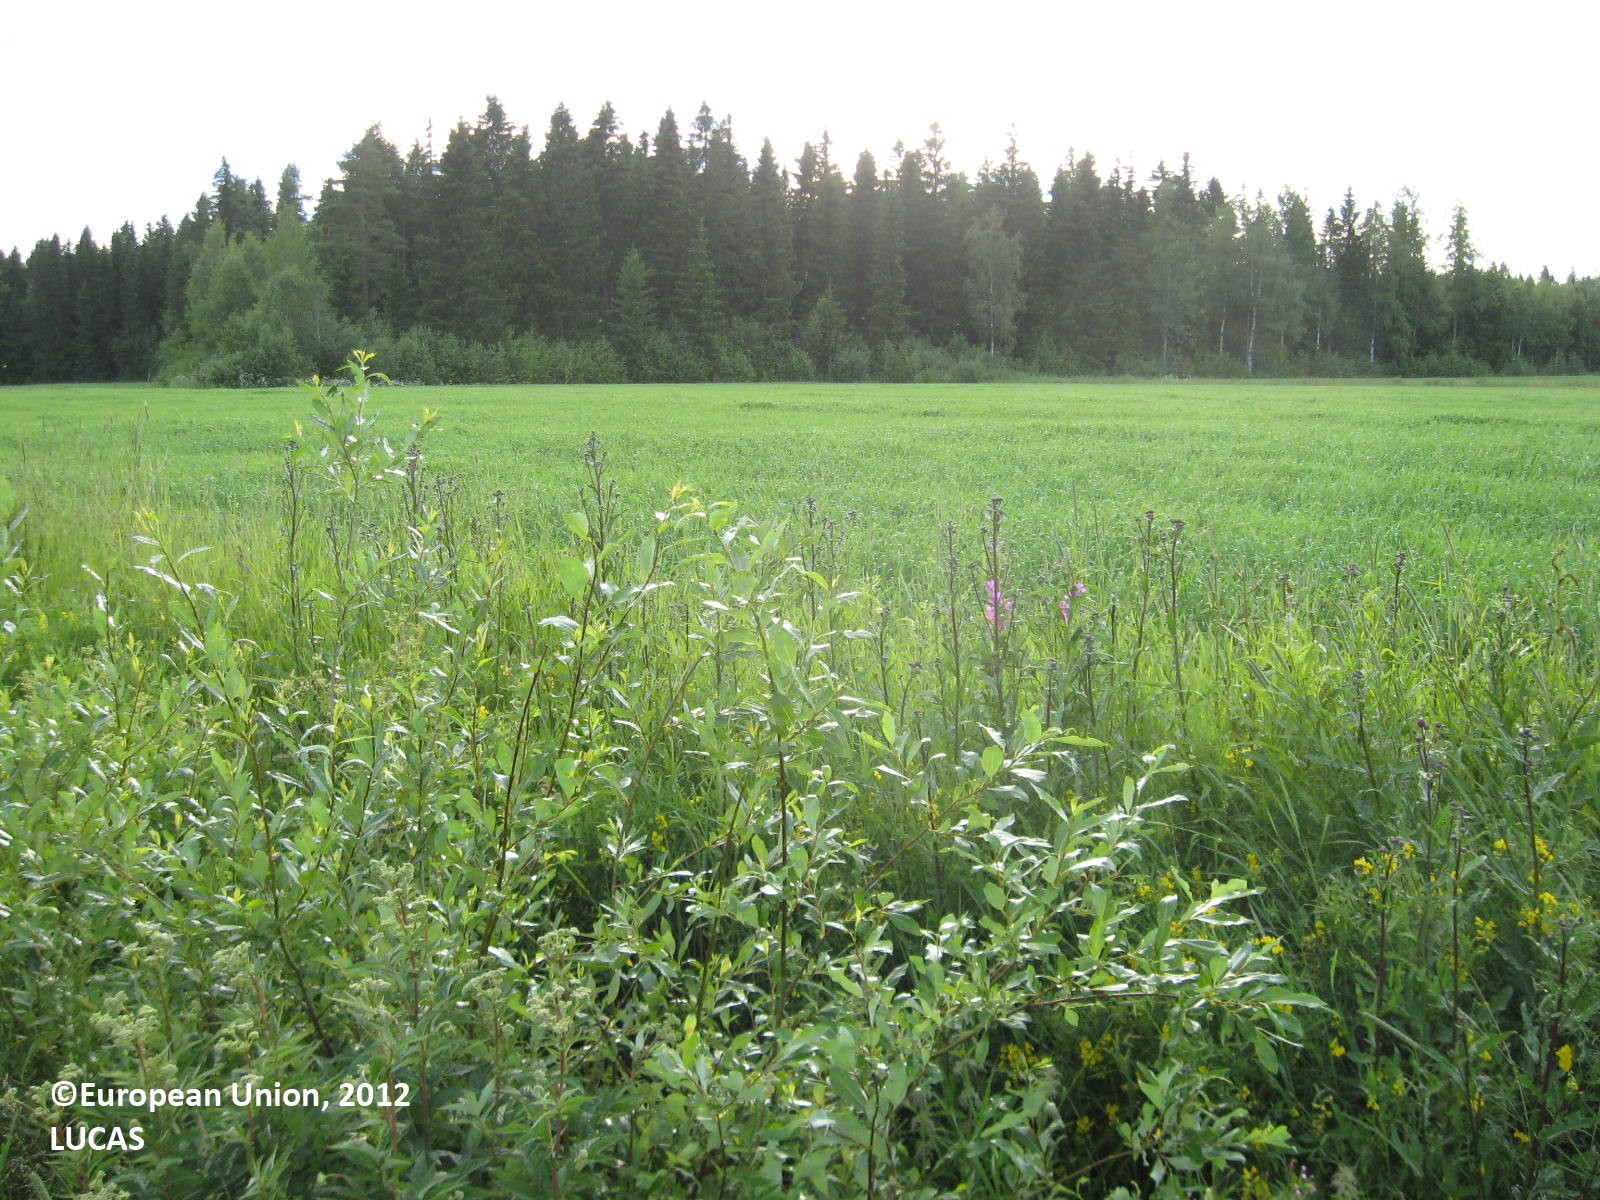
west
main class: Cropland
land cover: Barley
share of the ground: > 75 %
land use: Agriculture (excluding fallow land and kitchen gardens)
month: July
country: FI
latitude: 62.5354
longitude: 22.6321
